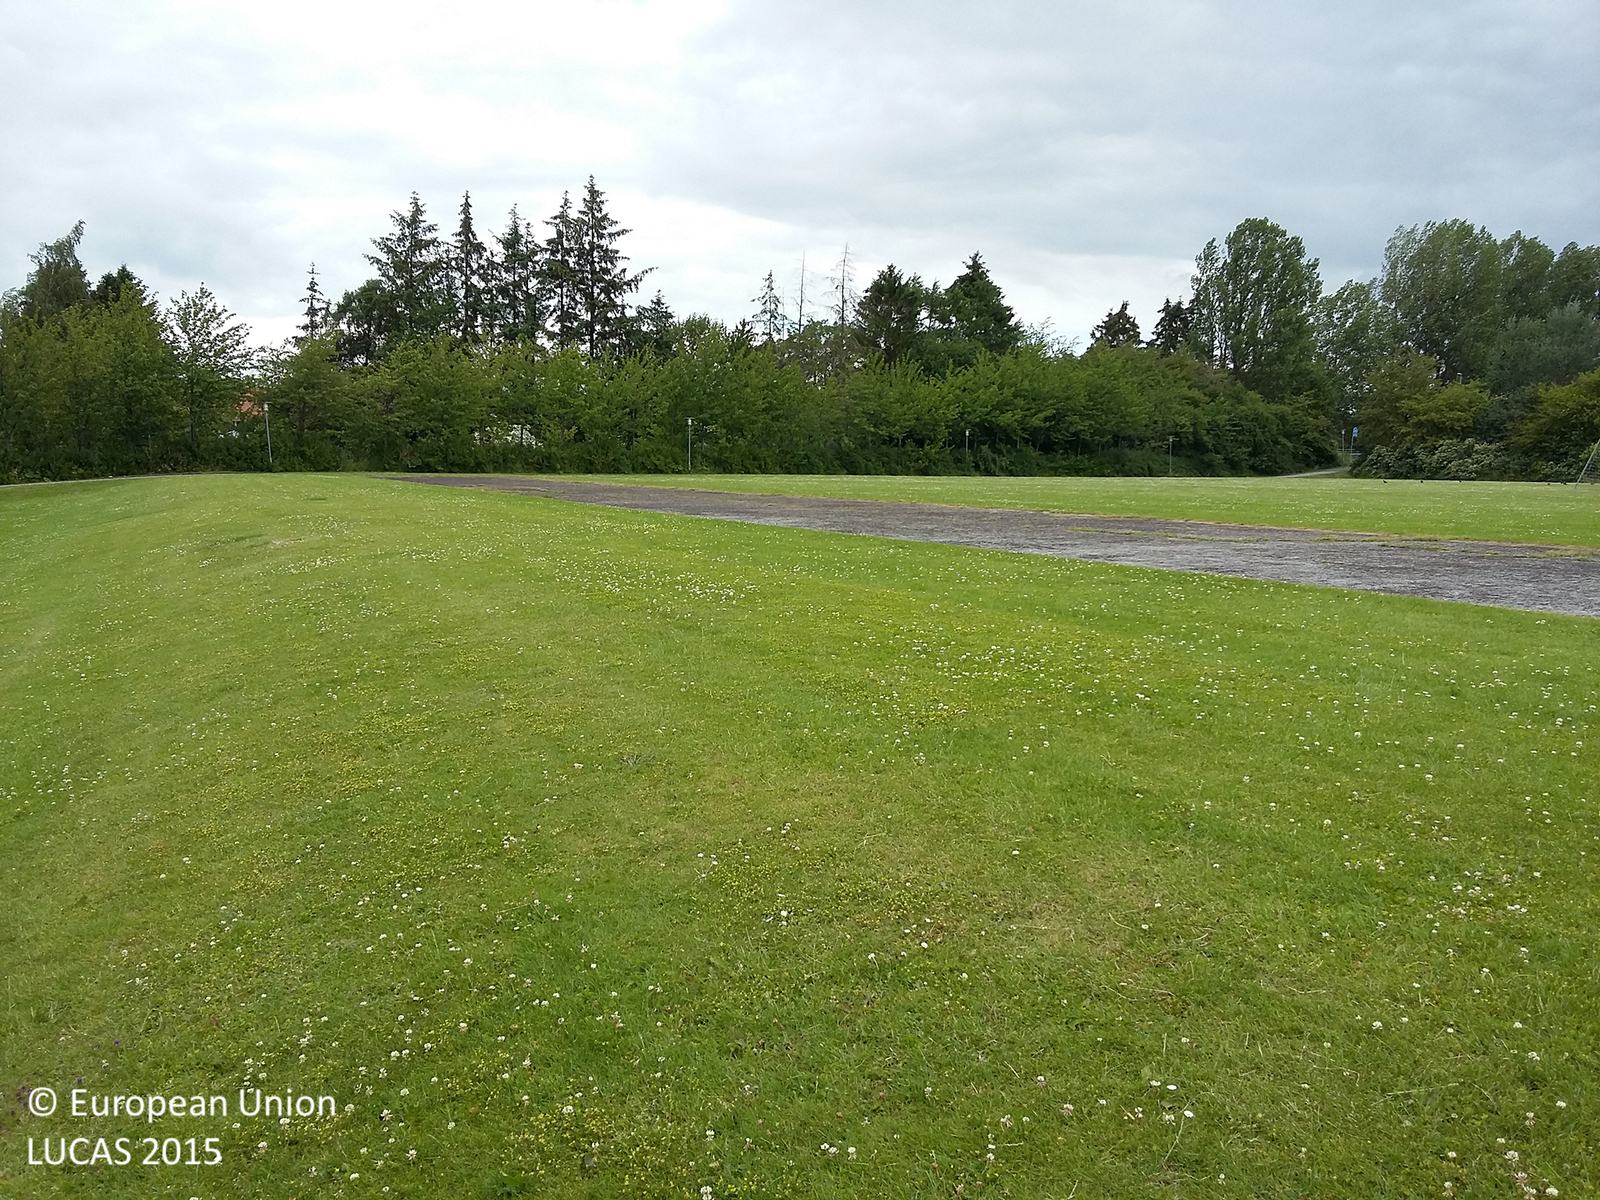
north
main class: Grassland
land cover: Grassland without tree/shrub cover
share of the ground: > 75 %
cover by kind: herbaceous plants 100 %
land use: Sport
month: July
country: DK
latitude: 55.2406
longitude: 11.7758
